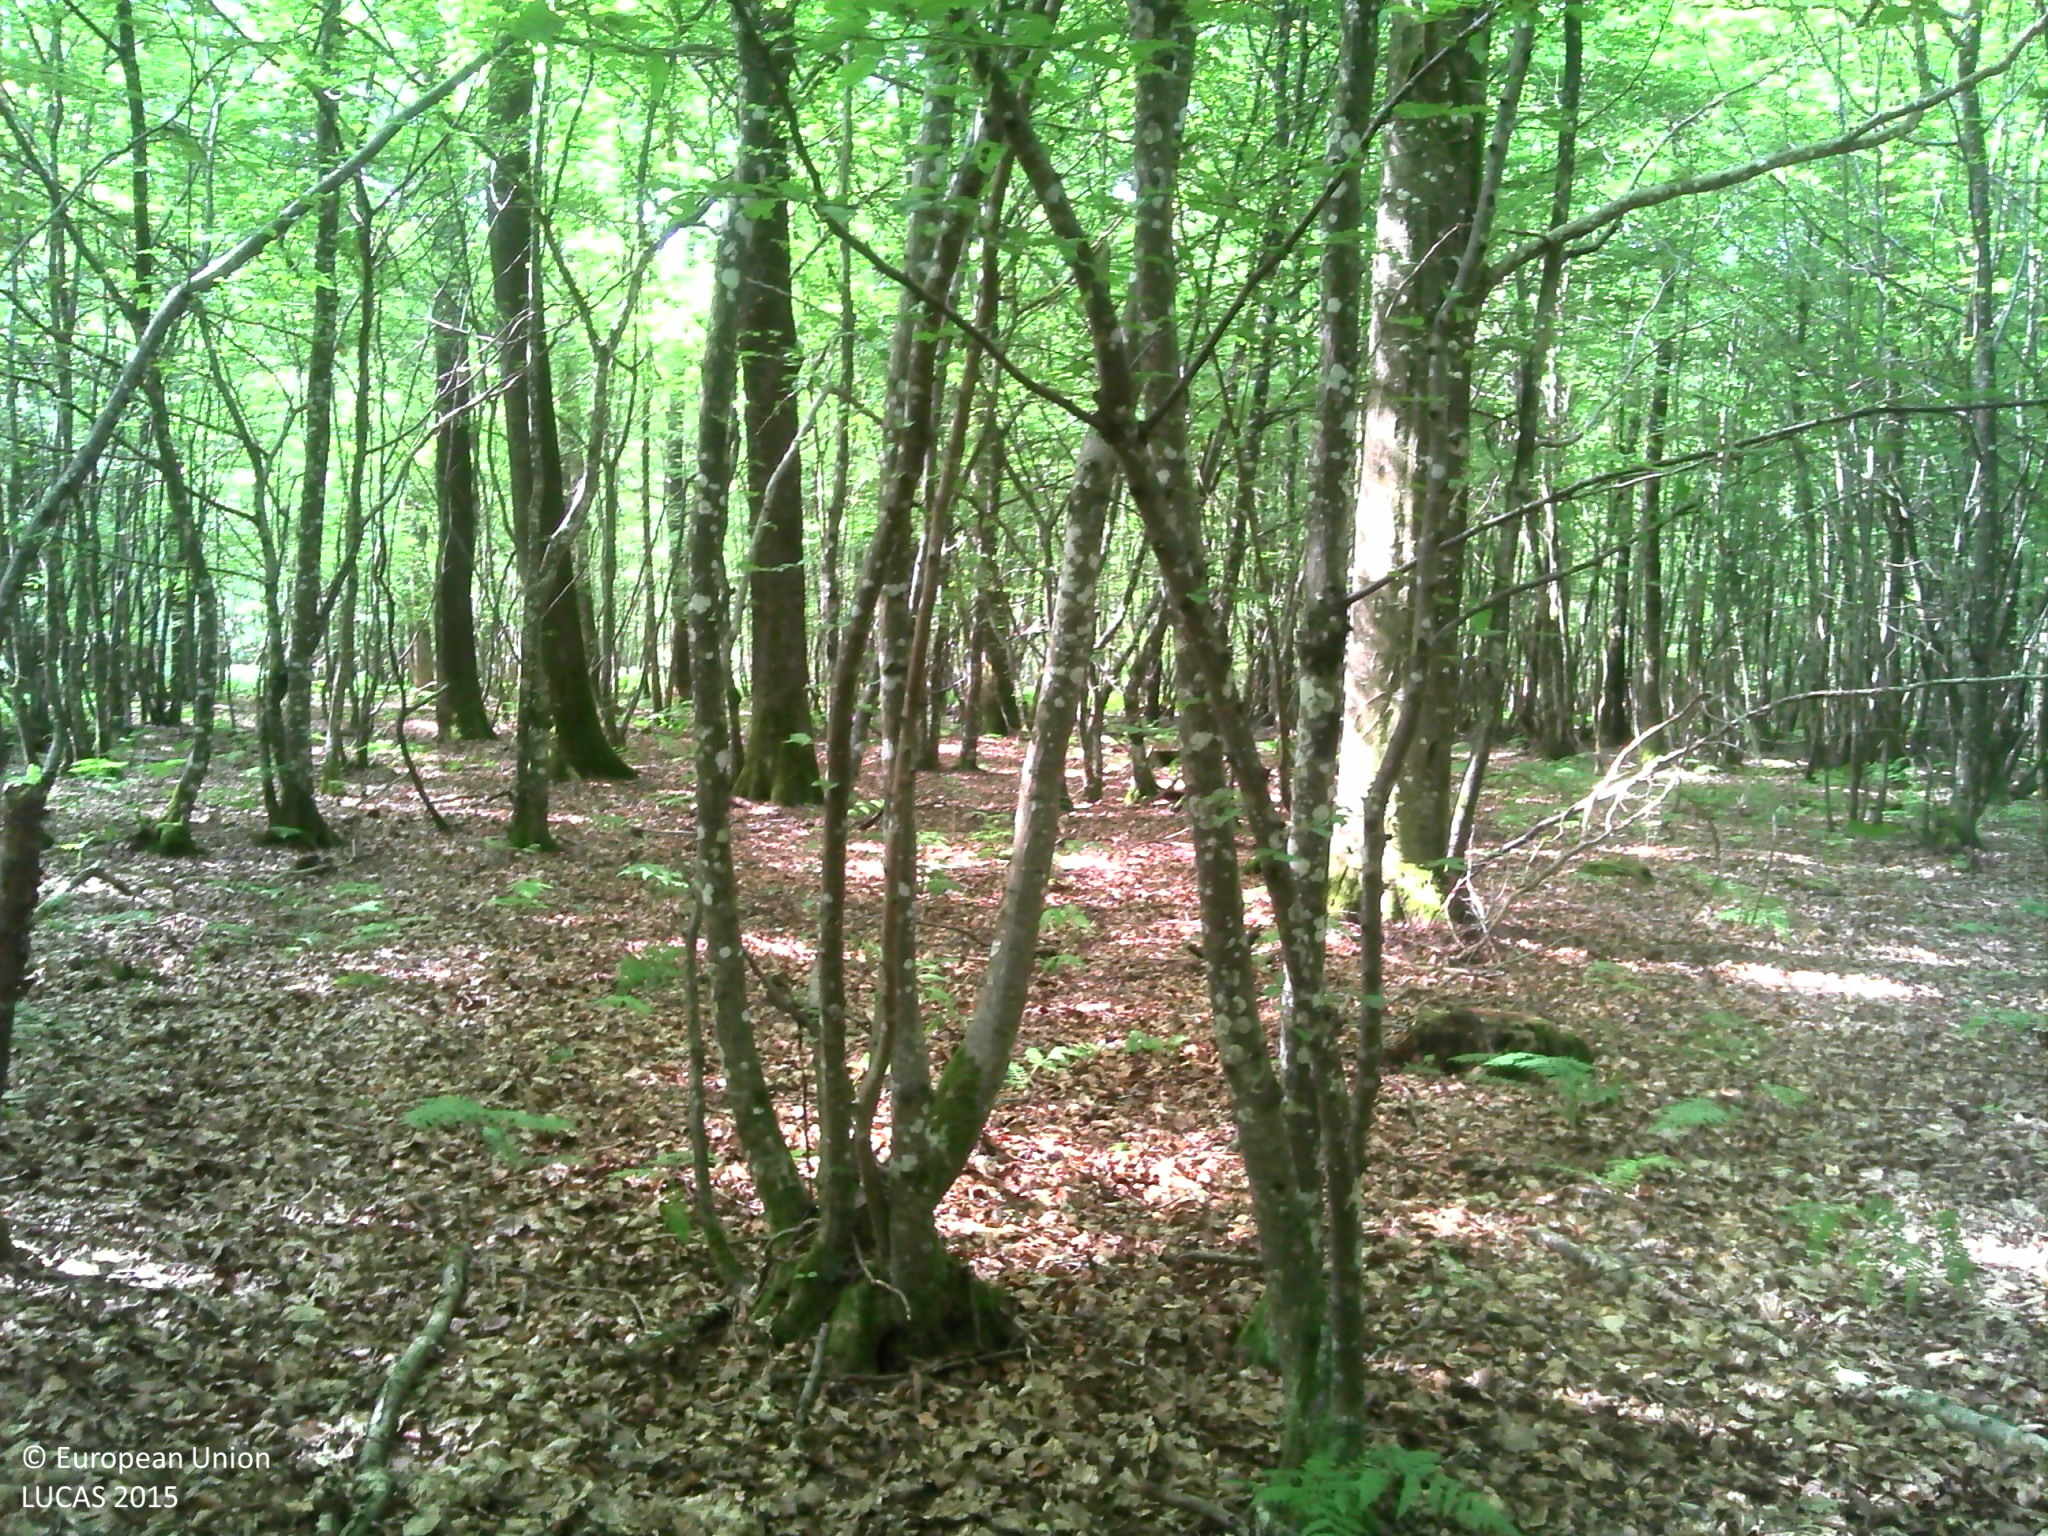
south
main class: Woodland
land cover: Broadleaved woodland
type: mesophytic deciduous forest
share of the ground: > 75 %
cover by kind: broadleaved forest trees 90 %, herbaceous plants 5 %, lichens and mosses 5 %
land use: Forestry
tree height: > 5 m
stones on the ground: < 10 %
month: June
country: FR
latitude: 48.0686
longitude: 3.5129
